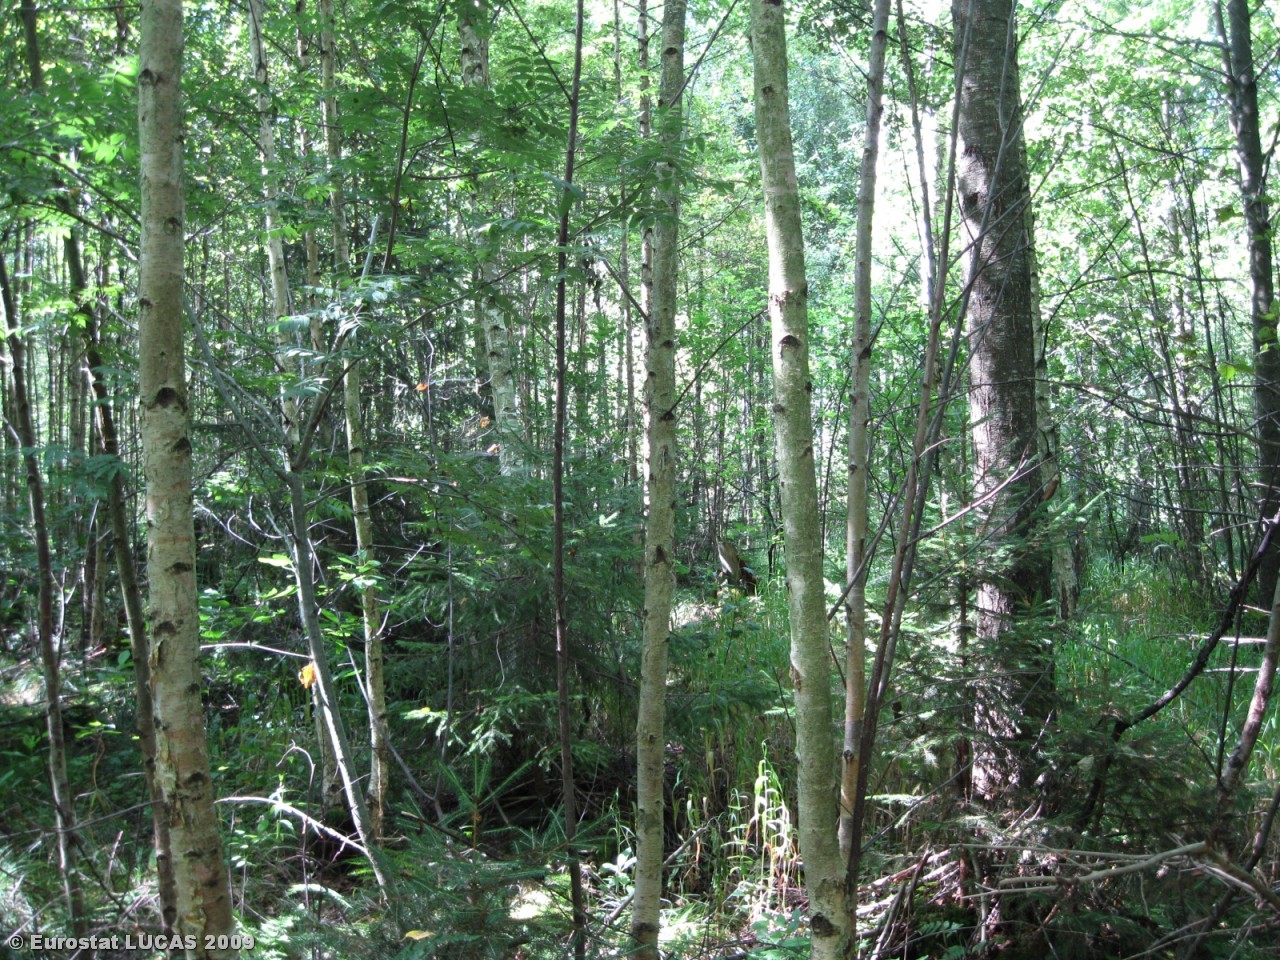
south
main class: Woodland
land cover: Broadleaved woodland
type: non-riverine alder, birch or aspen forest
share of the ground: > 75 %
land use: Forestry
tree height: > 5 m
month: August
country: LT
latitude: 54.7698
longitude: 23.5591
